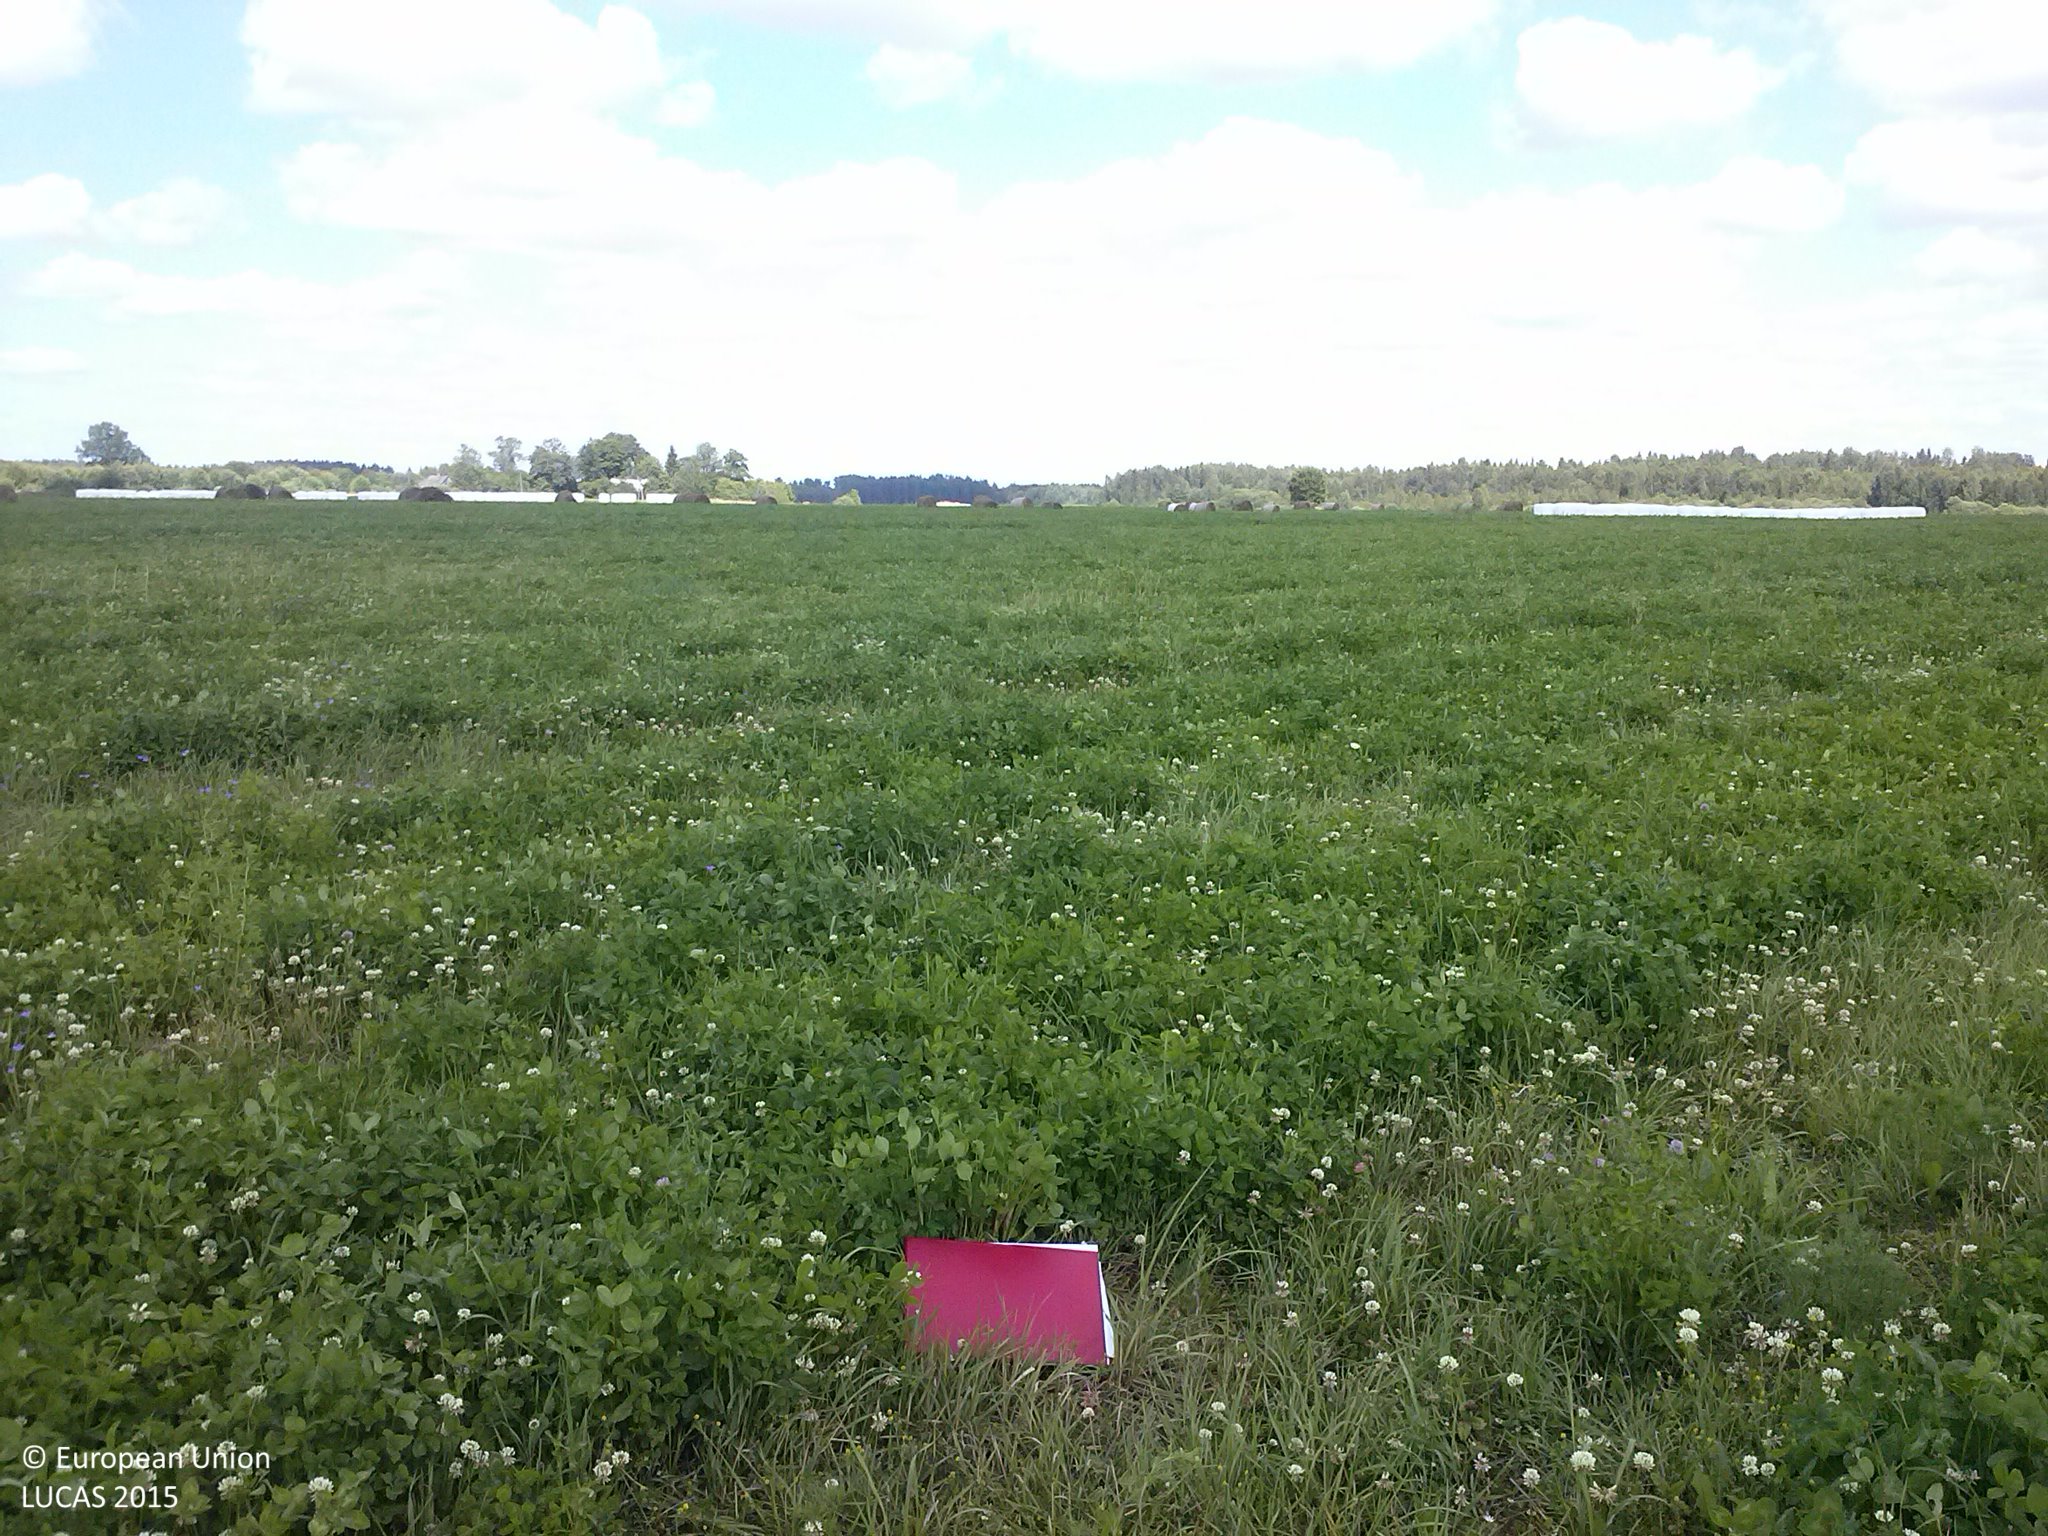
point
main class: Grassland
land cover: Grassland without tree/shrub cover
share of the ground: > 75 %
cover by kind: herbaceous plants 100 %
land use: Agriculture (excluding fallow land and kitchen gardens)
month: July
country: LV
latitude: 56.5129
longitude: 27.0157
